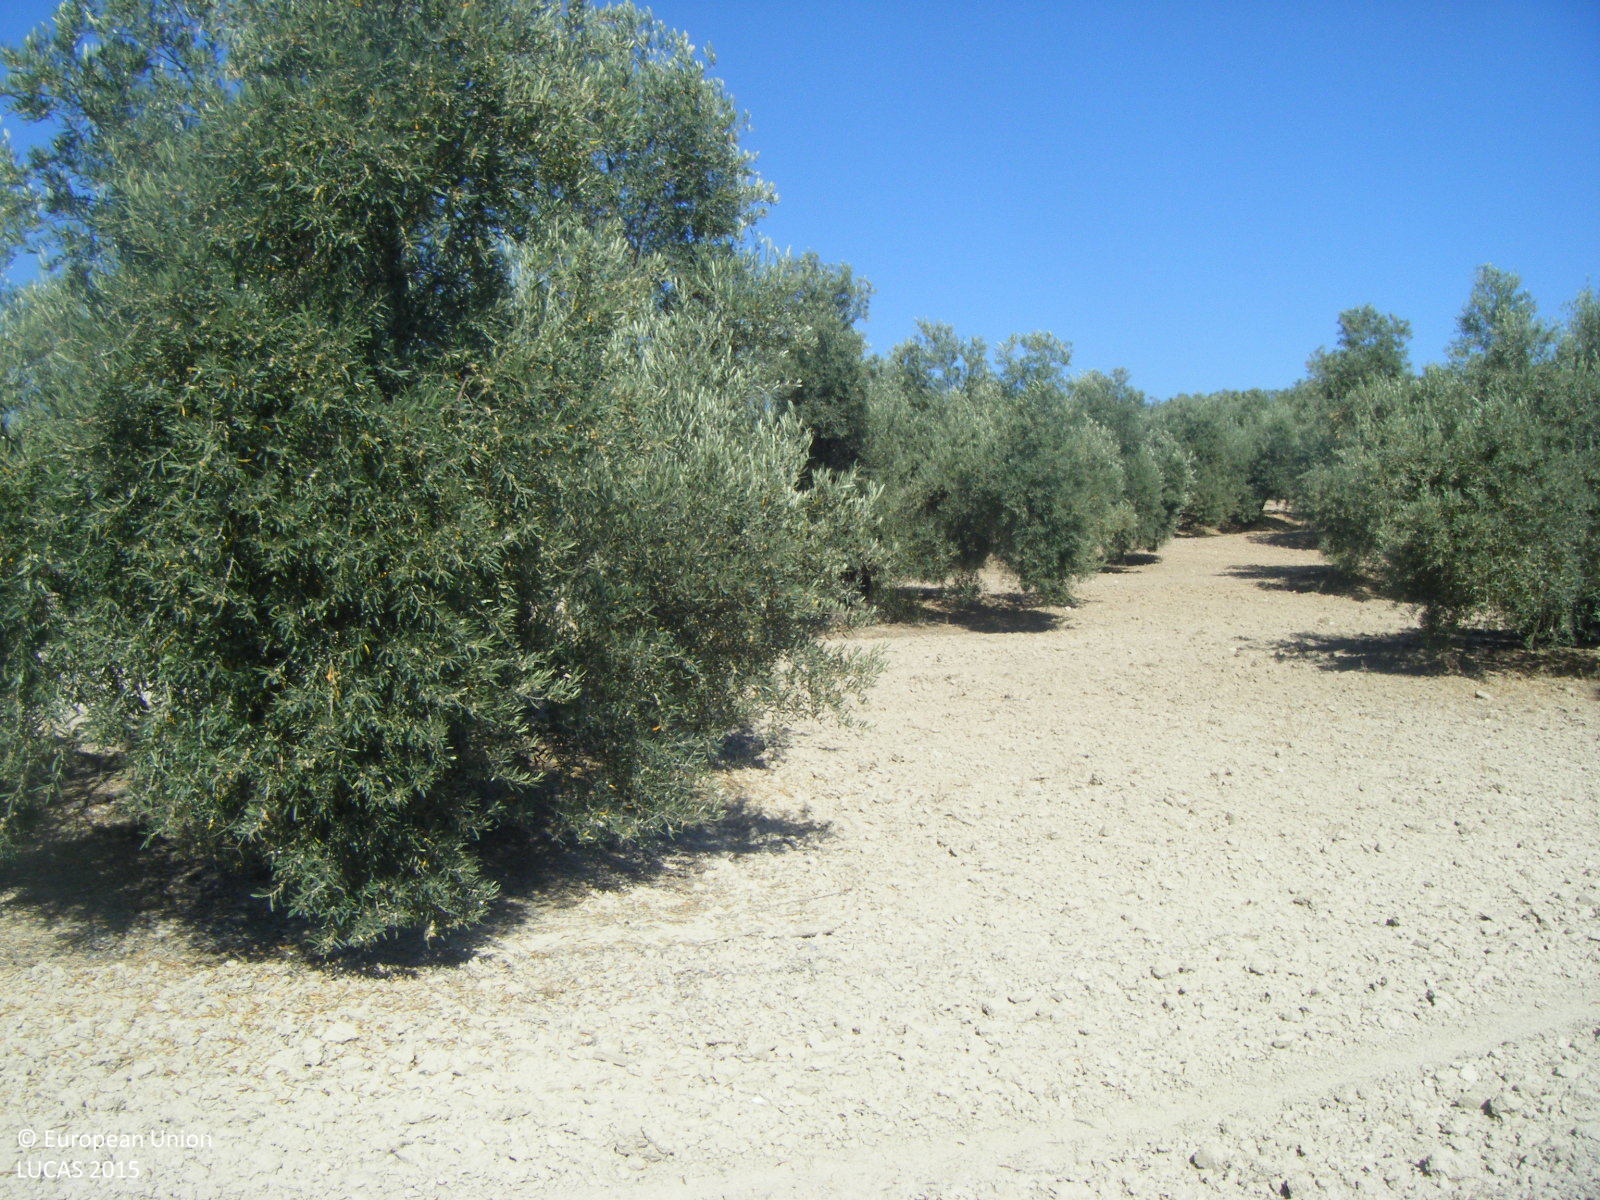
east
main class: Cropland
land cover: Olive groves
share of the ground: 10 - 25 %
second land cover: Other bare soil
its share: > 75 %
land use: Agriculture (excluding fallow land and kitchen gardens)
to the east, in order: Olive groves; Other bare soil
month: June
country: ES
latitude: 37.2890
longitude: -4.5181
